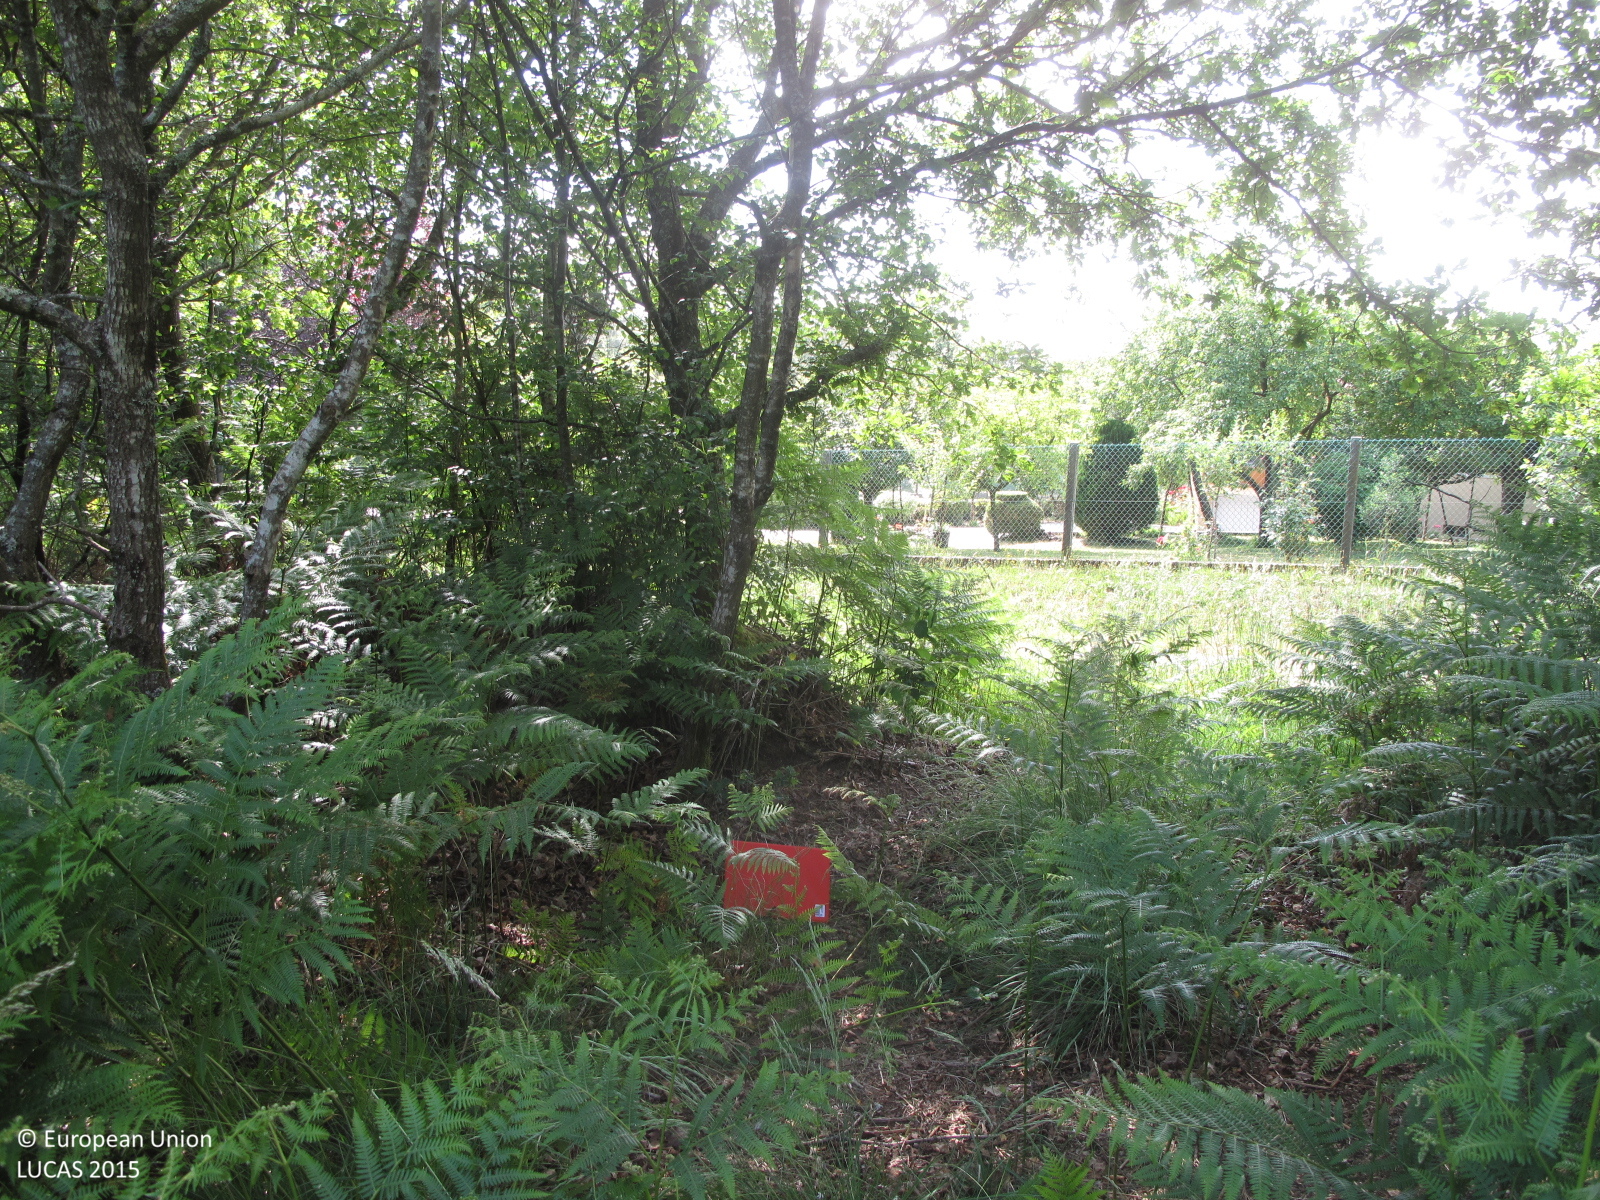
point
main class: Woodland
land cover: Broadleaved woodland
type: acidophilous oak and oak-birch forest
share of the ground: 25 - 50 %
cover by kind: herbaceous plants 60 %, broadleaved forest trees 30 %, shrubs 10 %
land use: Forestry
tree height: > 5 m
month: June
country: ES
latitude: 42.9504
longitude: -8.4767
